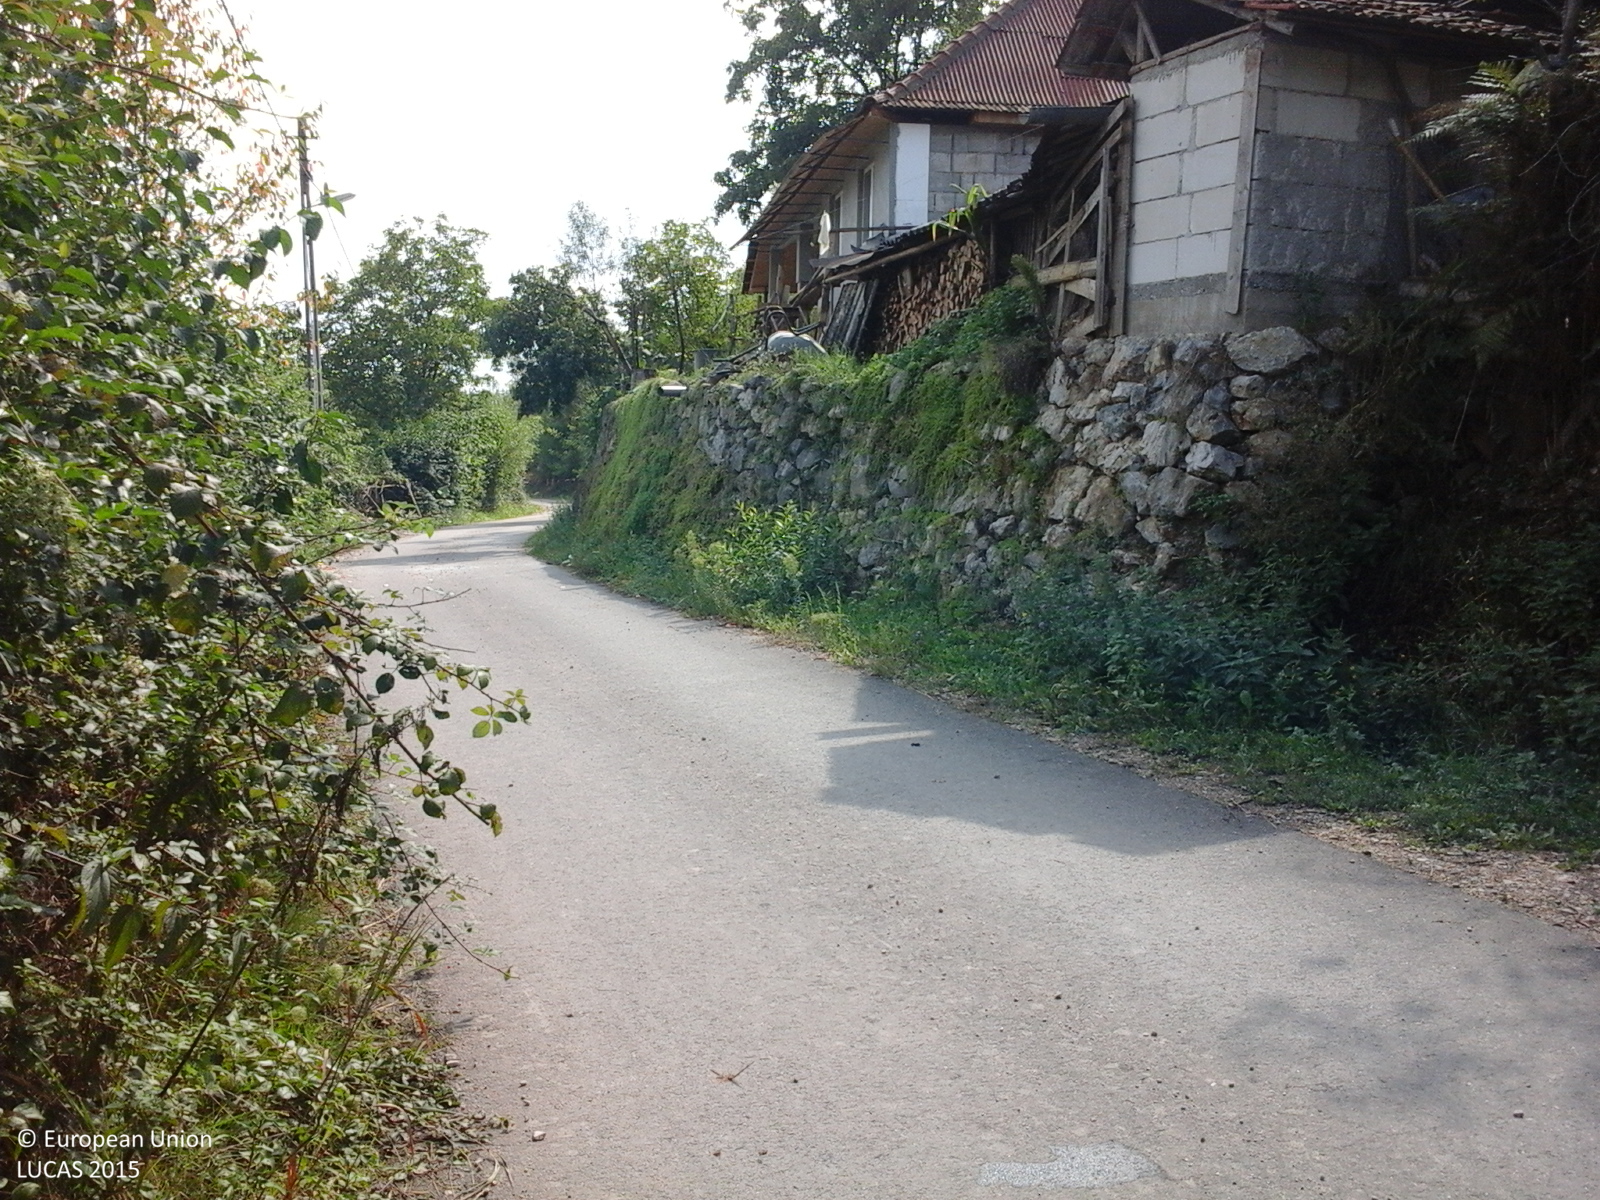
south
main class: Cropland
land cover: Maize
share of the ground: > 75 %
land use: Agriculture (excluding fallow land and kitchen gardens)
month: September
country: RO
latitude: 46.7767
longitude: 22.3752
